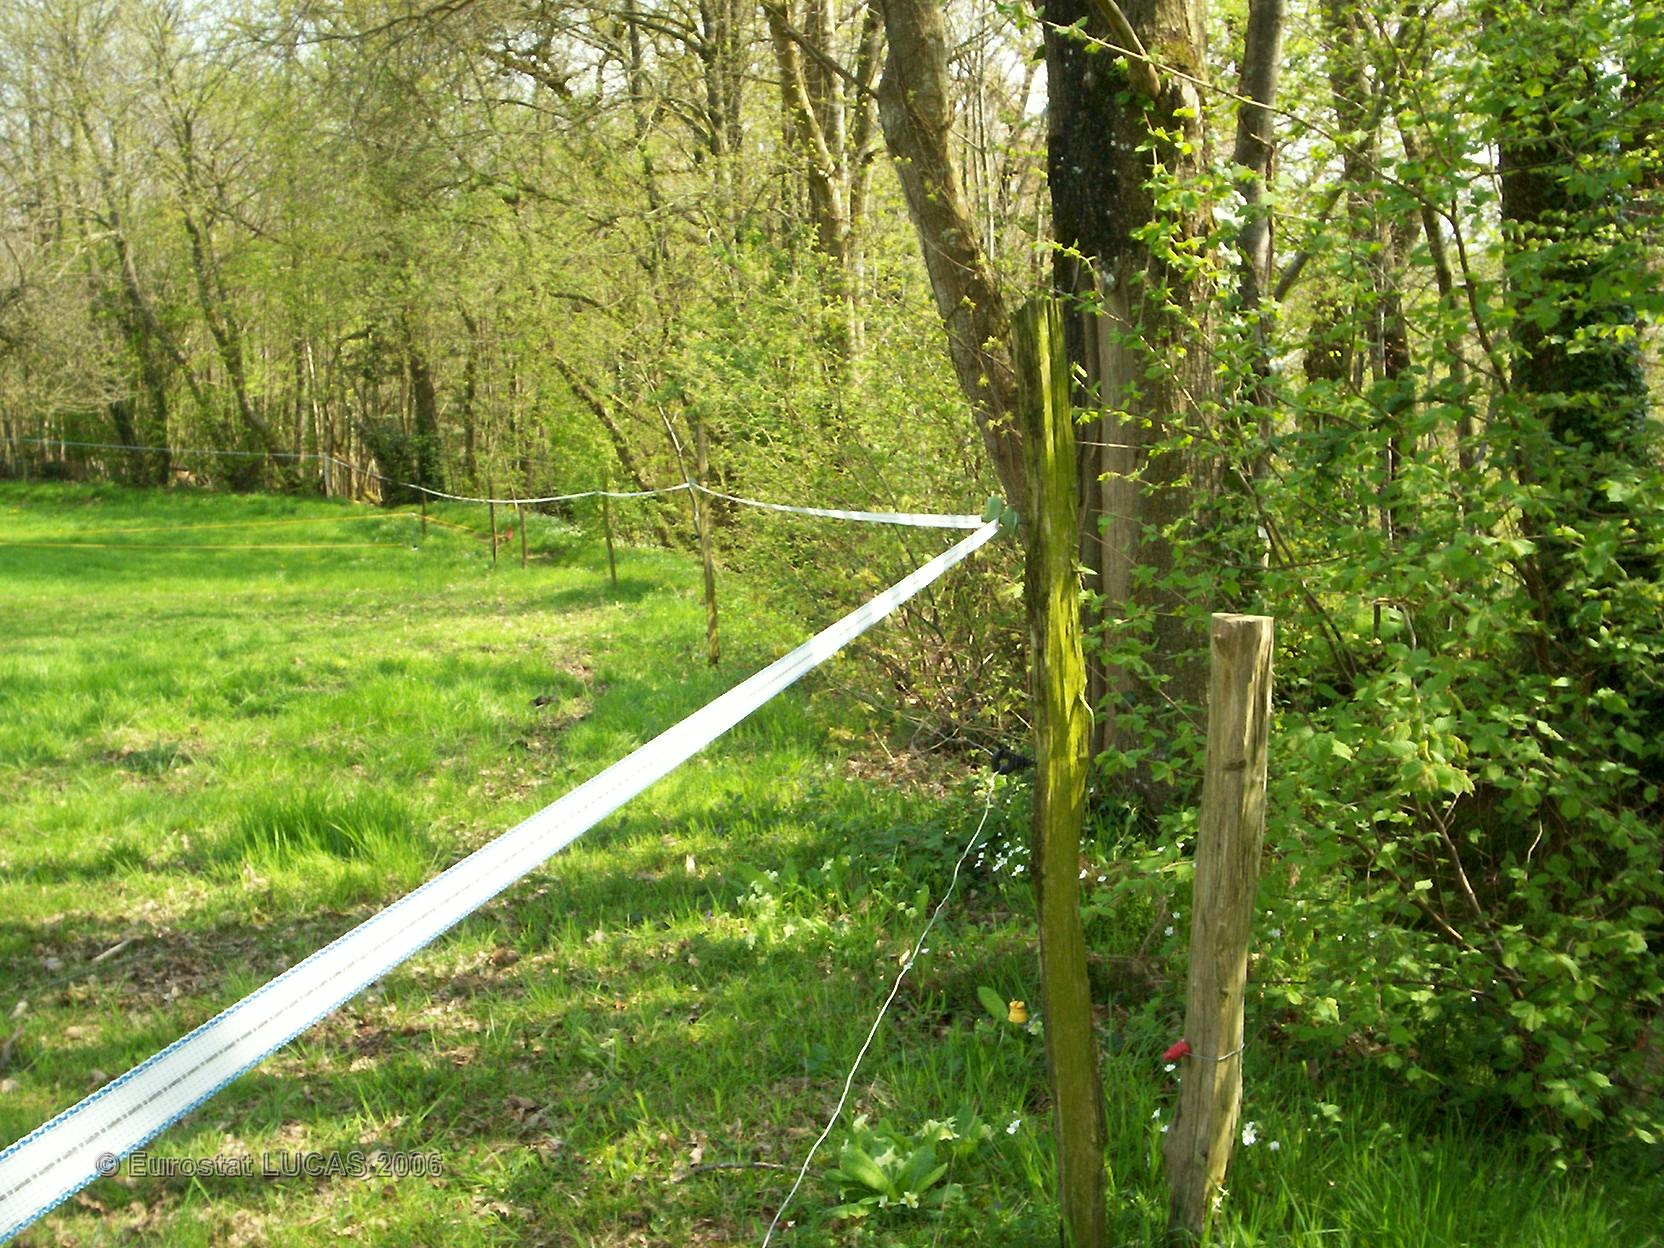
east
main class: Grassland
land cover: Grassland without tree/shrub cover
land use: Agriculture (excluding fallow land and kitchen gardens)
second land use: Sport
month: May
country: FR
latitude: 48.2768
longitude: -2.4705
